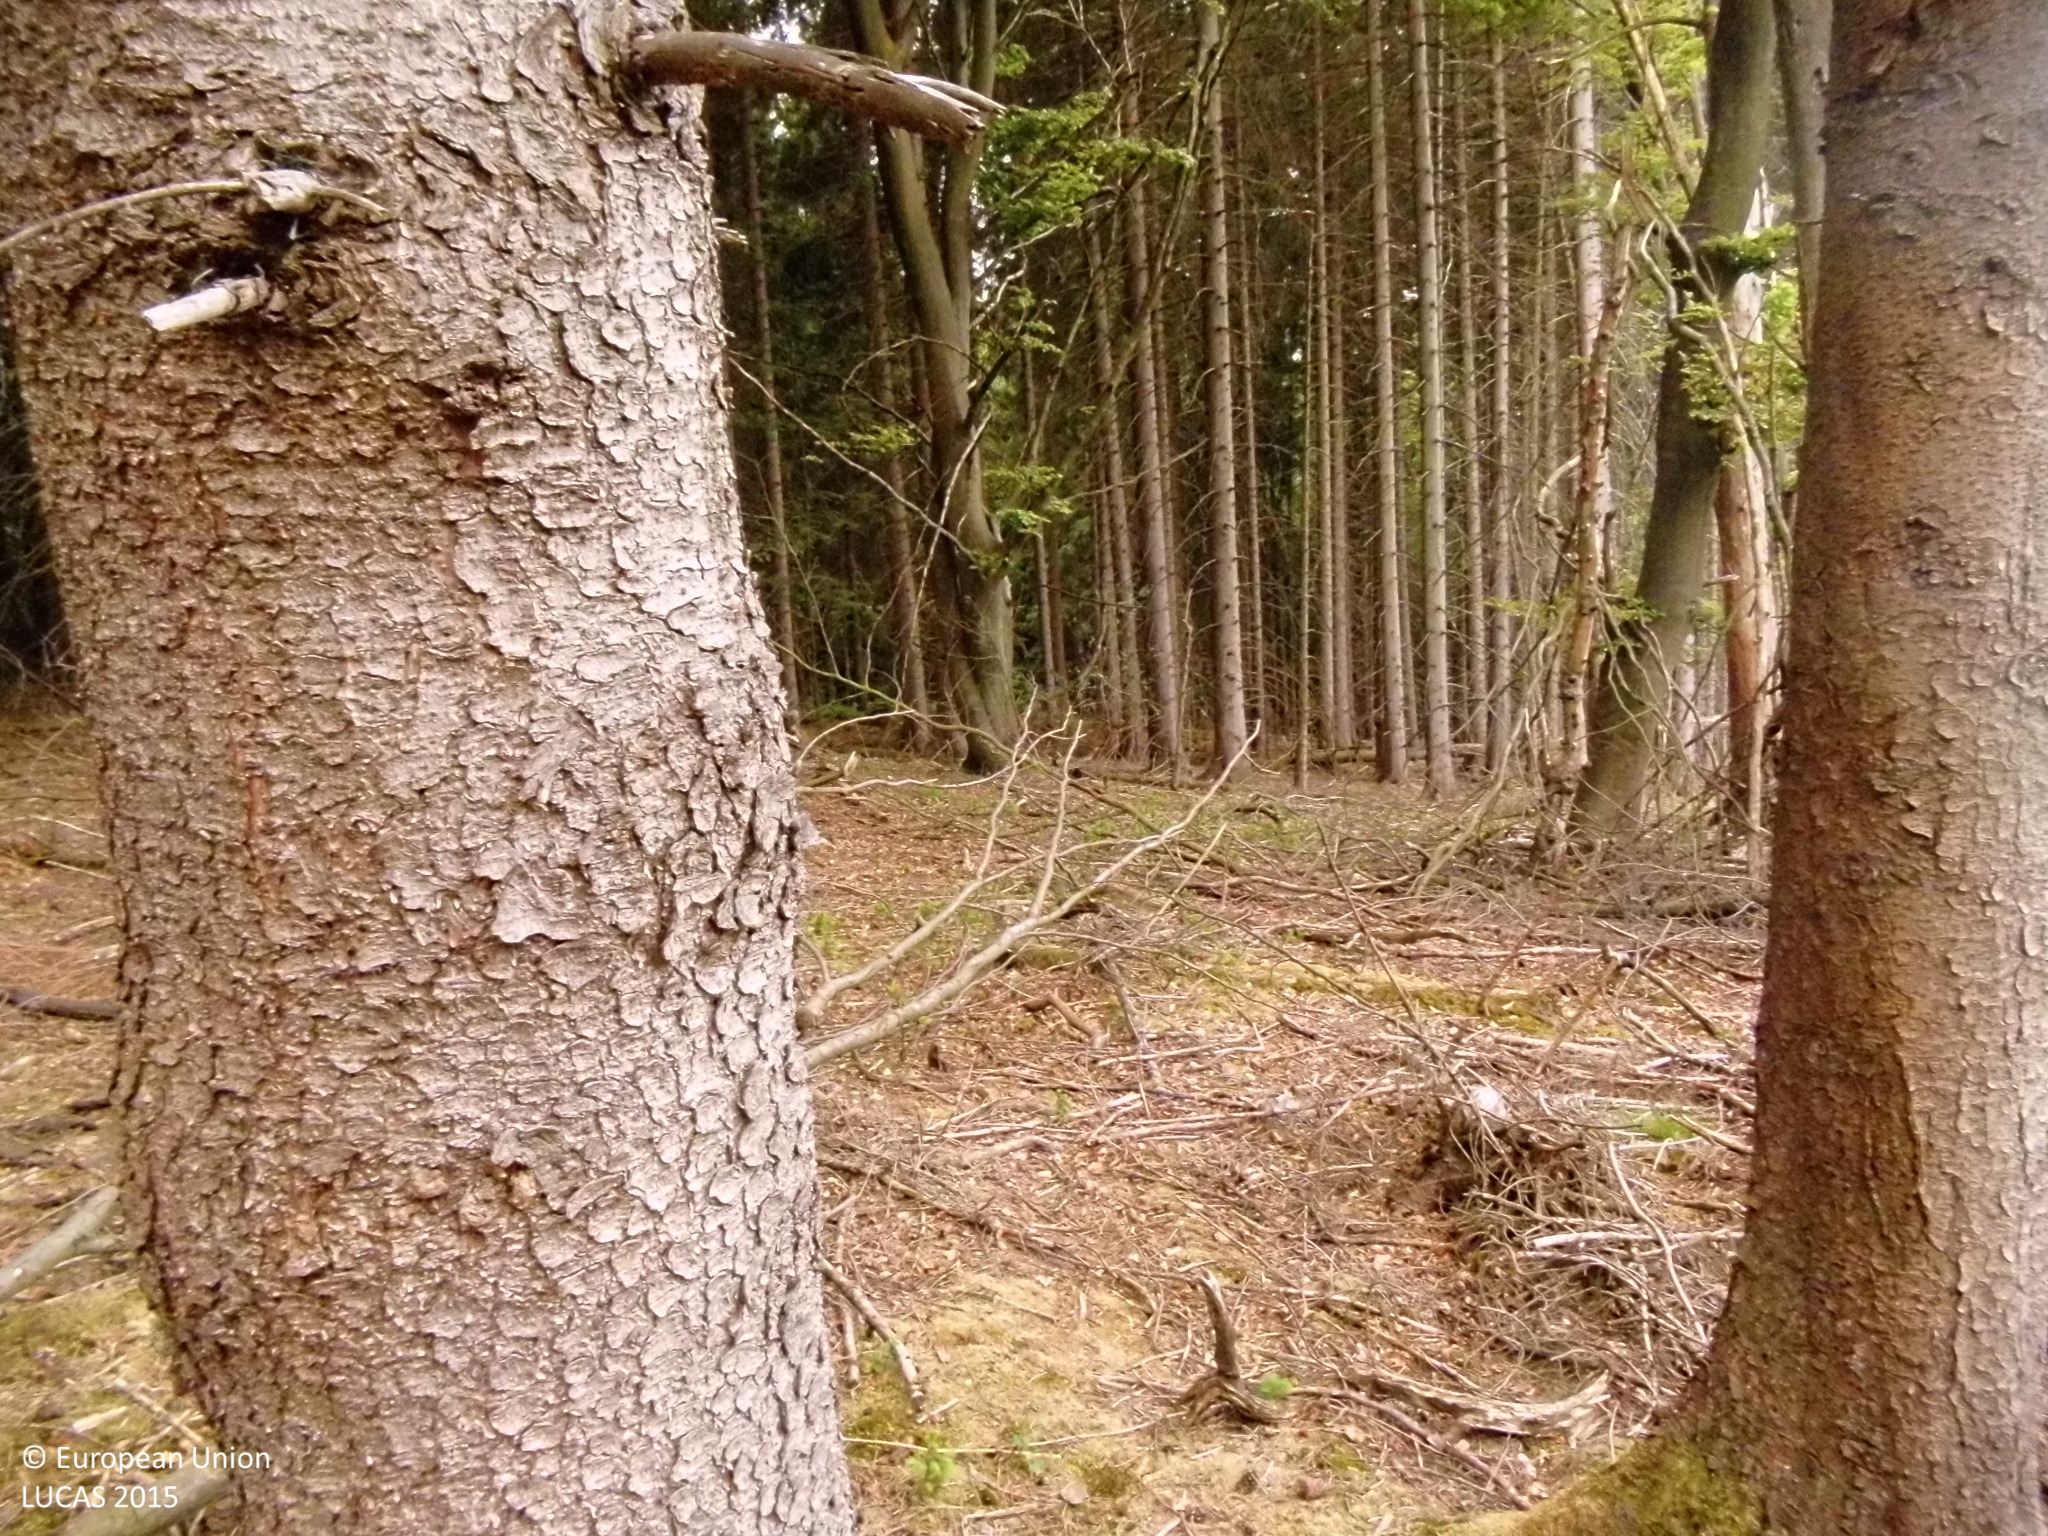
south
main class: Woodland
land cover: Other mixed woodland
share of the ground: > 75 %
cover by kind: coniferous forest trees 40 %, broadleaved forest trees 40 %, lichens and mosses 10 %, herbaceous plants 5 %, unconsolidated bare surface 5 %
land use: Forestry
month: May
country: DE
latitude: 50.9120
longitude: 7.4828
